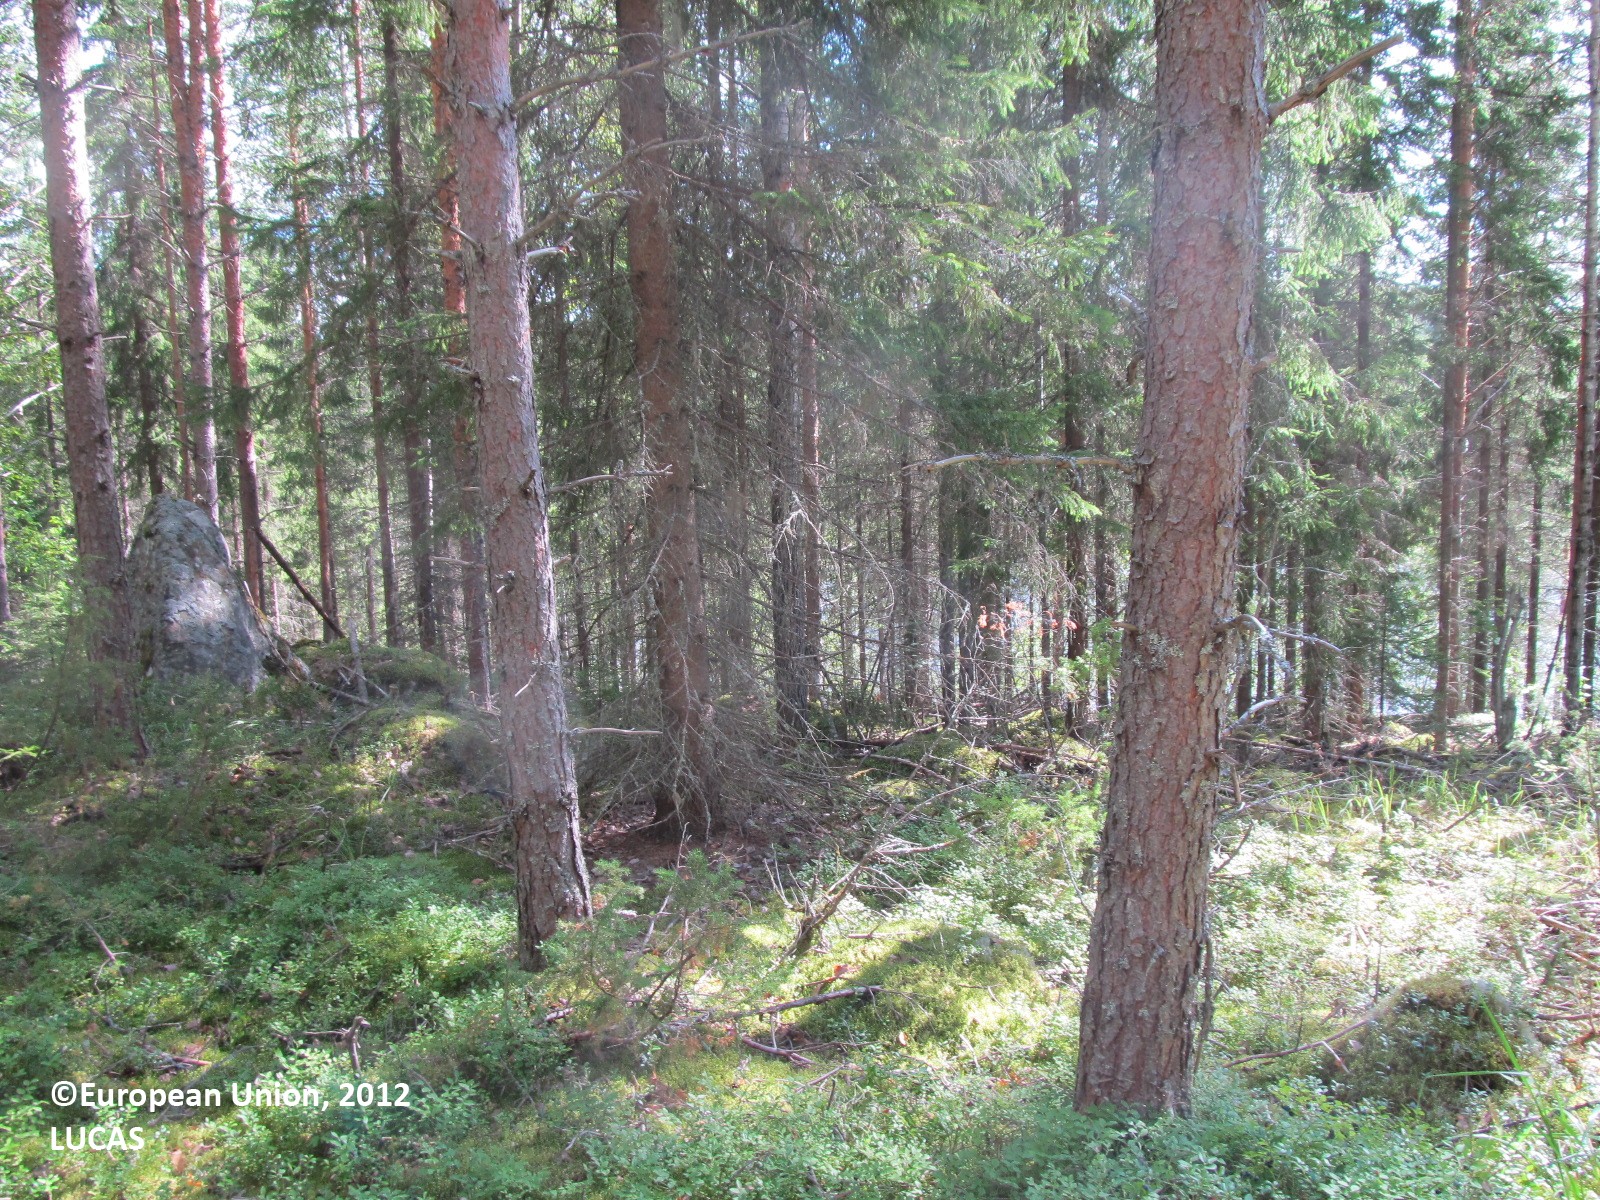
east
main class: Woodland
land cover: Other coniferous woodland
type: boreal forest
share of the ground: 25 - 50 %
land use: Forestry
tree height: > 5 m
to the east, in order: Other coniferous woodland; Pine dominated coniferous woodland; Spruce dominated coniferous woodland; Broadleaved woodland; Spruce dominated coniferous woodland; Spruce dominated mixed woodland; Ditches and canals; Spruce dominated coniferous woodland; Broadleaved woodland; Spruce dominated coniferous woodland
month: August
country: FI
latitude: 61.6762
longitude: 27.4233
